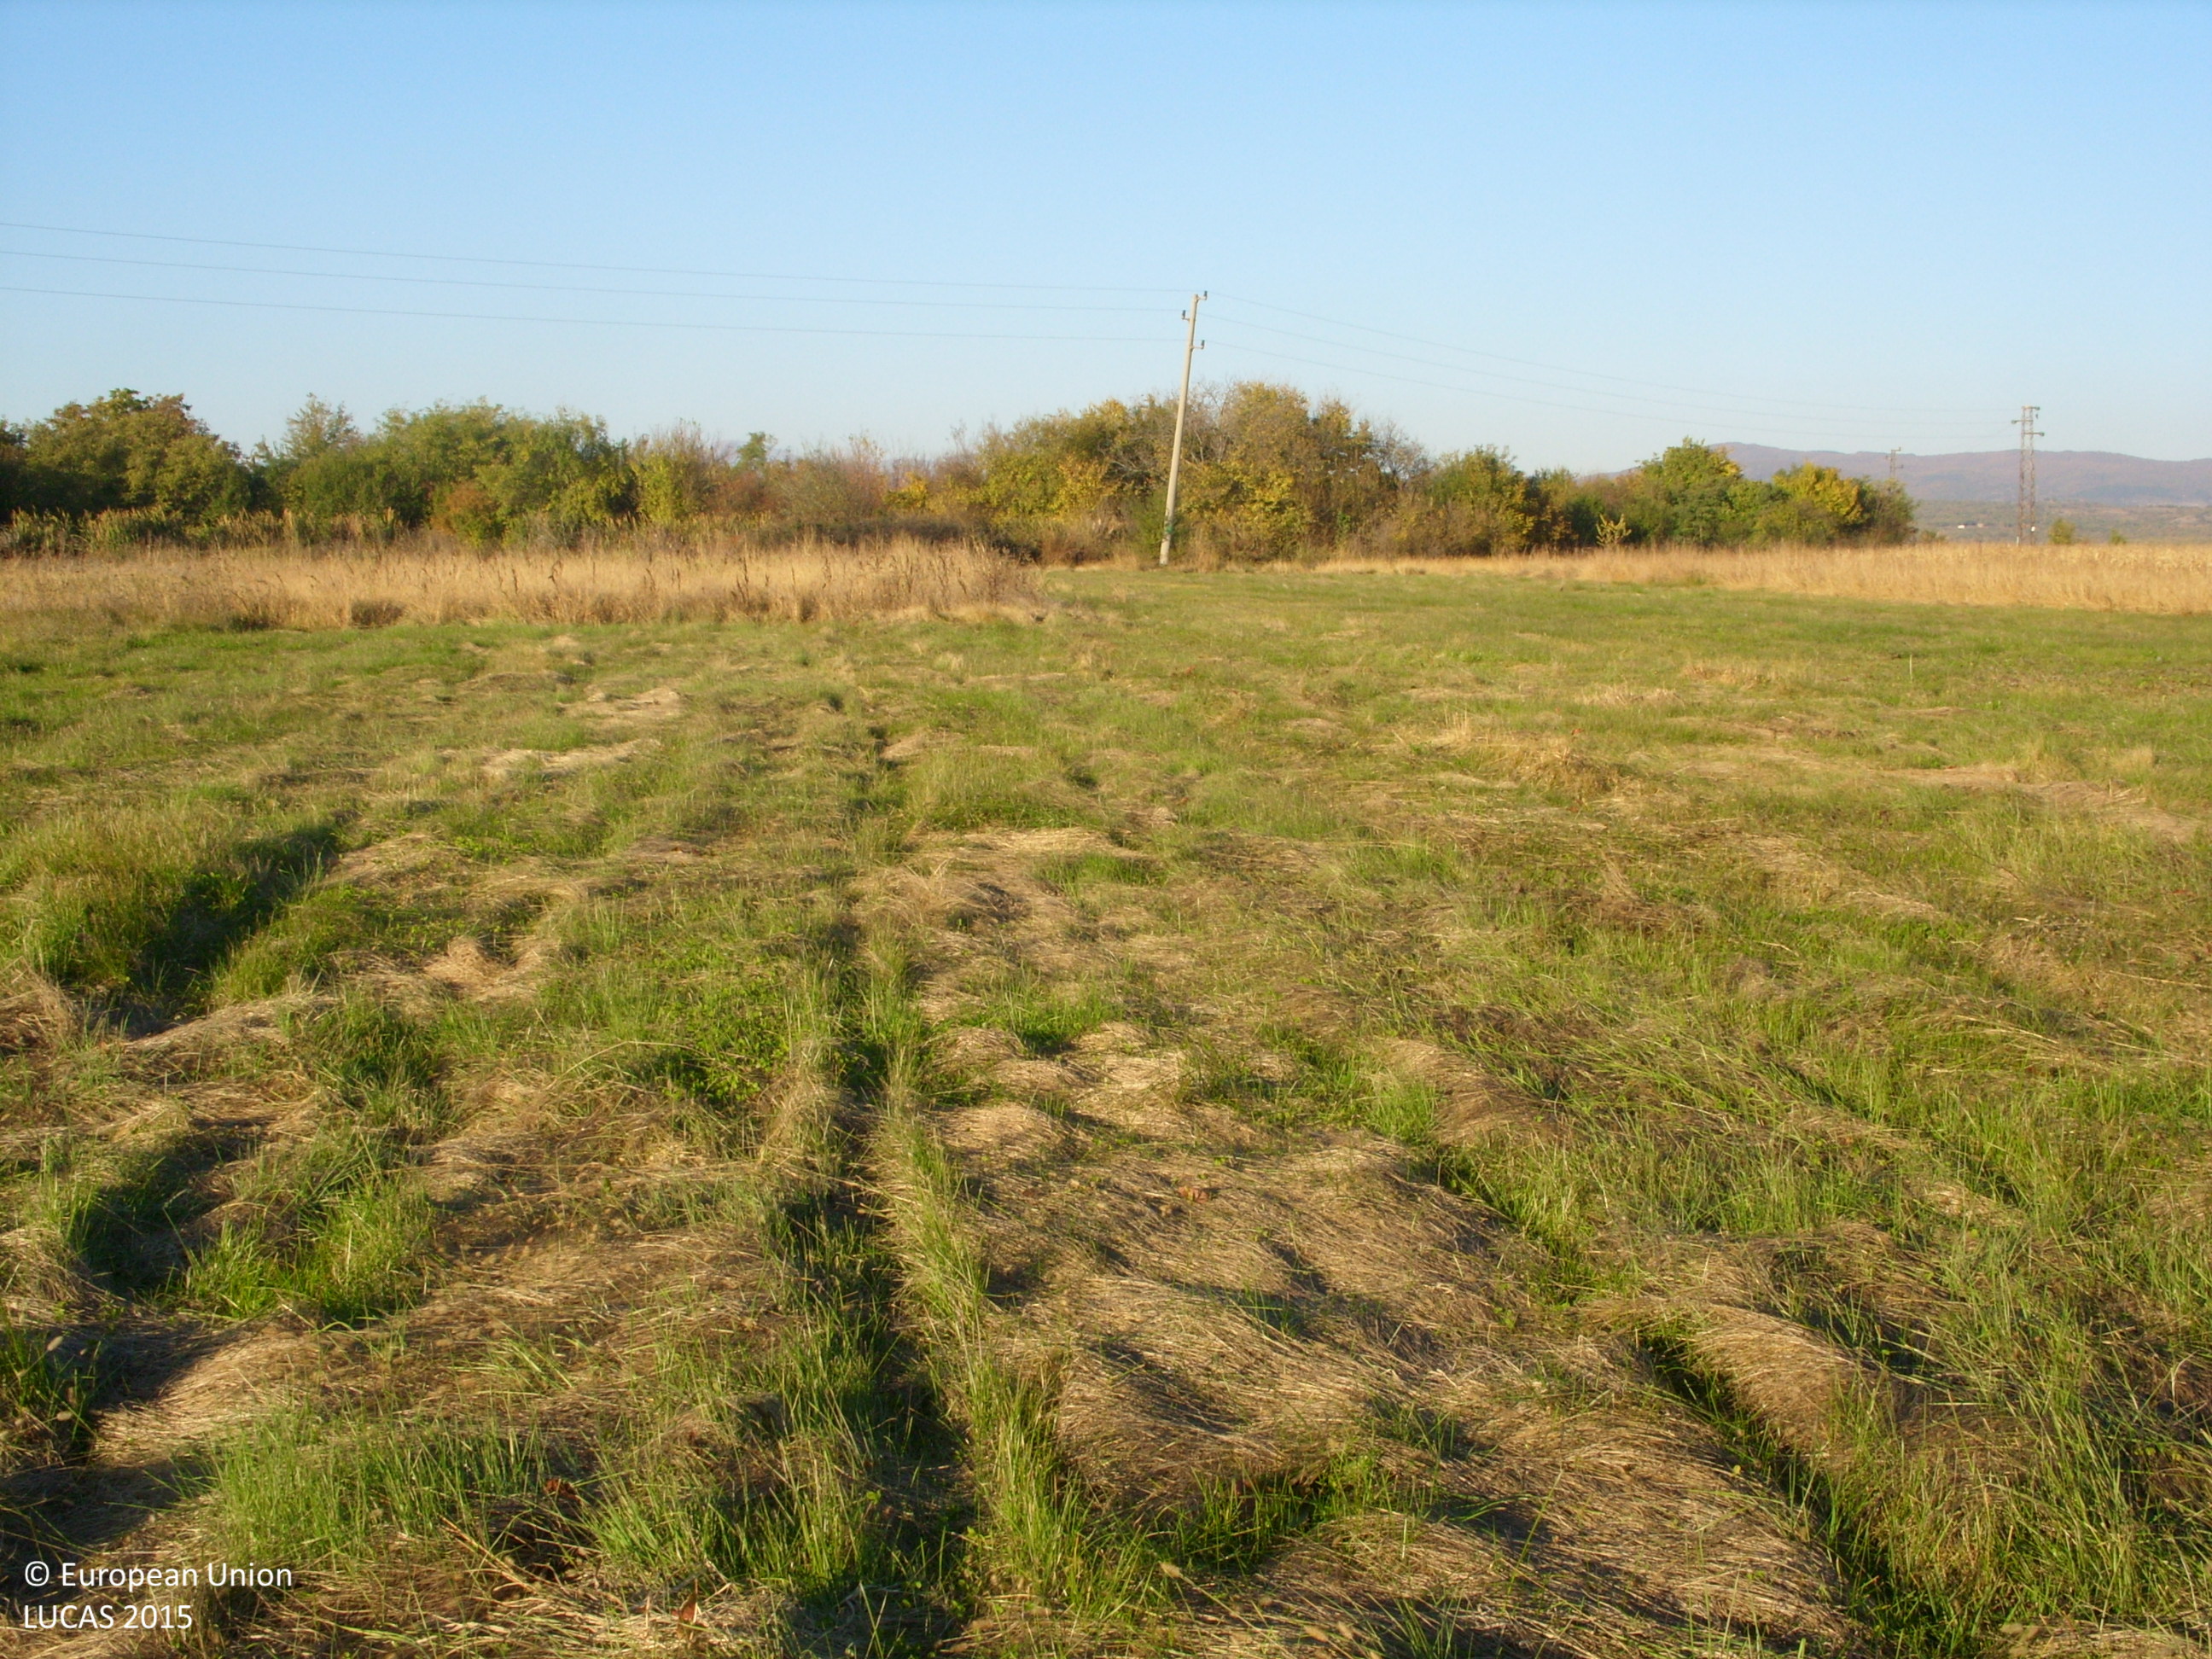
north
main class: Grassland
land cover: Grassland without tree/shrub cover
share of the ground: > 75 %
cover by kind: herbaceous plants 100 %
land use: Agriculture (excluding fallow land and kitchen gardens)
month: November
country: BG
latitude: 42.4110
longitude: 24.8692
